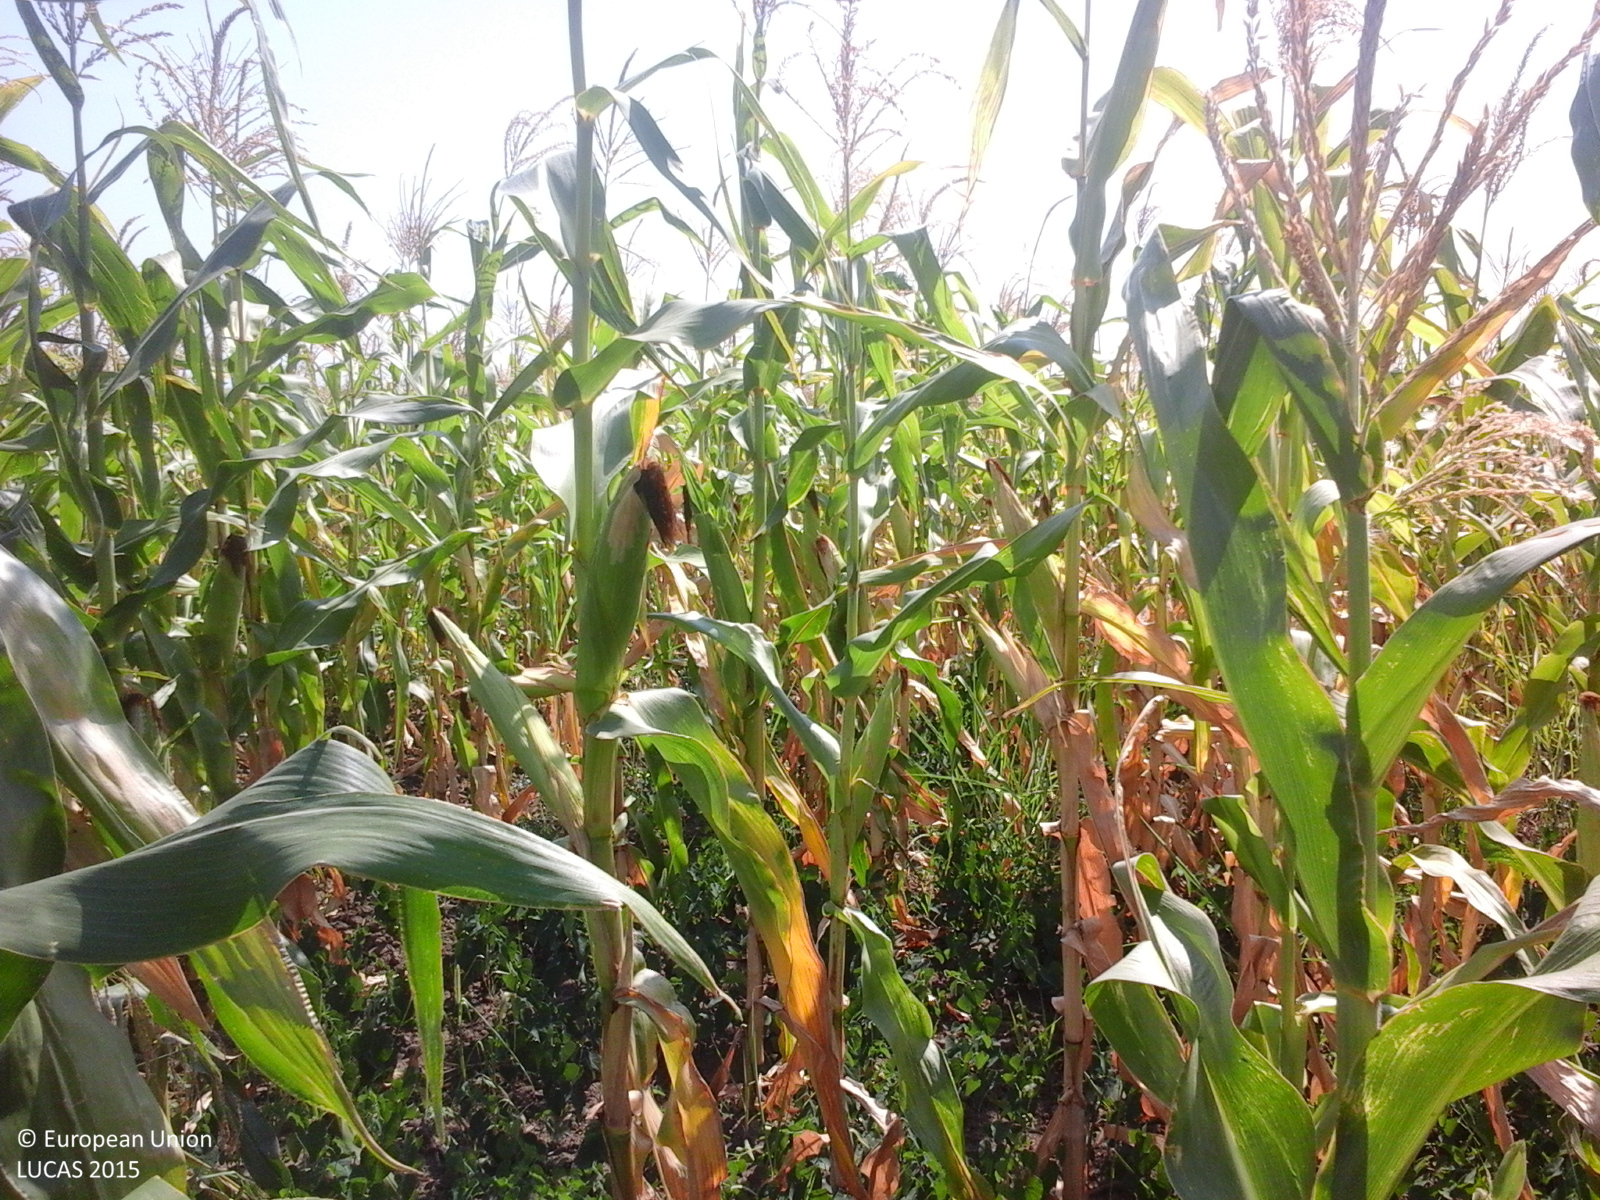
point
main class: Cropland
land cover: Maize
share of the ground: > 75 %
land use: Agriculture (excluding fallow land and kitchen gardens)
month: August
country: RO
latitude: 45.7546
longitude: 27.4188
